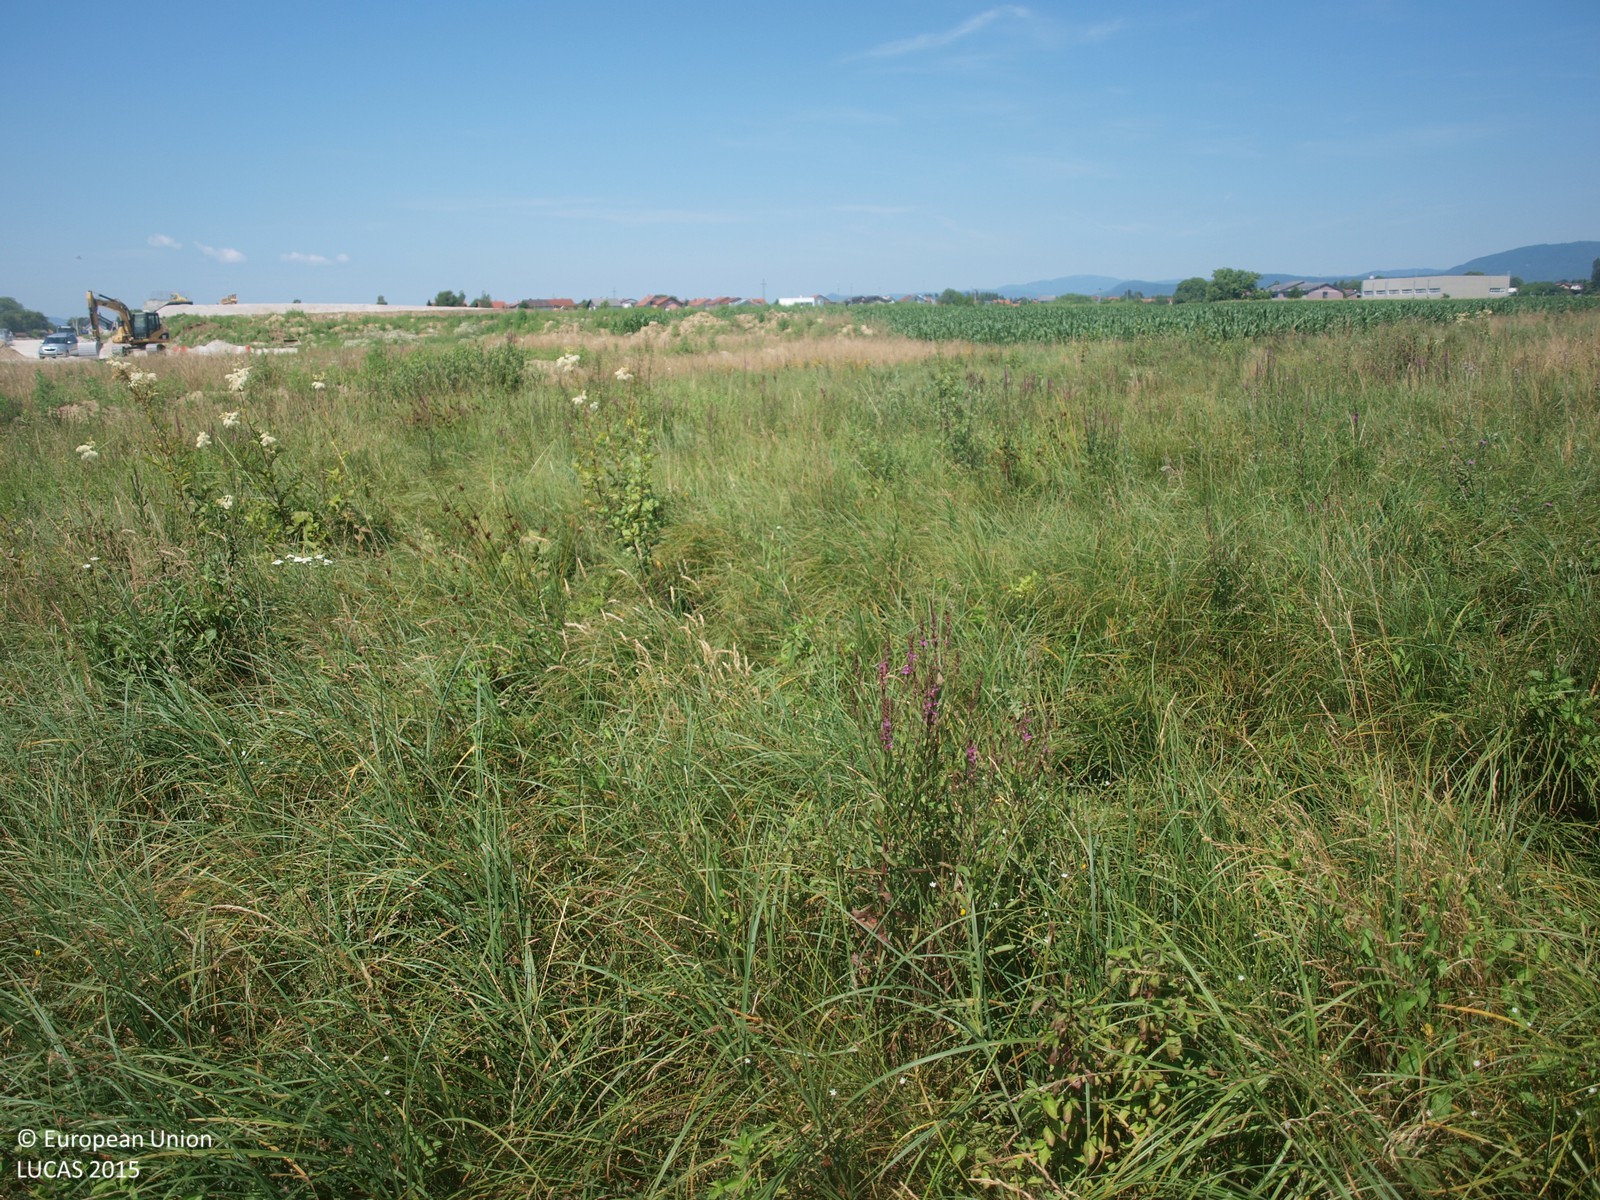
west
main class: Grassland
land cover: Grassland without tree/shrub cover
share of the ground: > 75 %
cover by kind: herbaceous plants 100 %
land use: Agriculture (excluding fallow land and kitchen gardens)
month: July
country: HR
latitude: 45.6598
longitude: 15.6567
